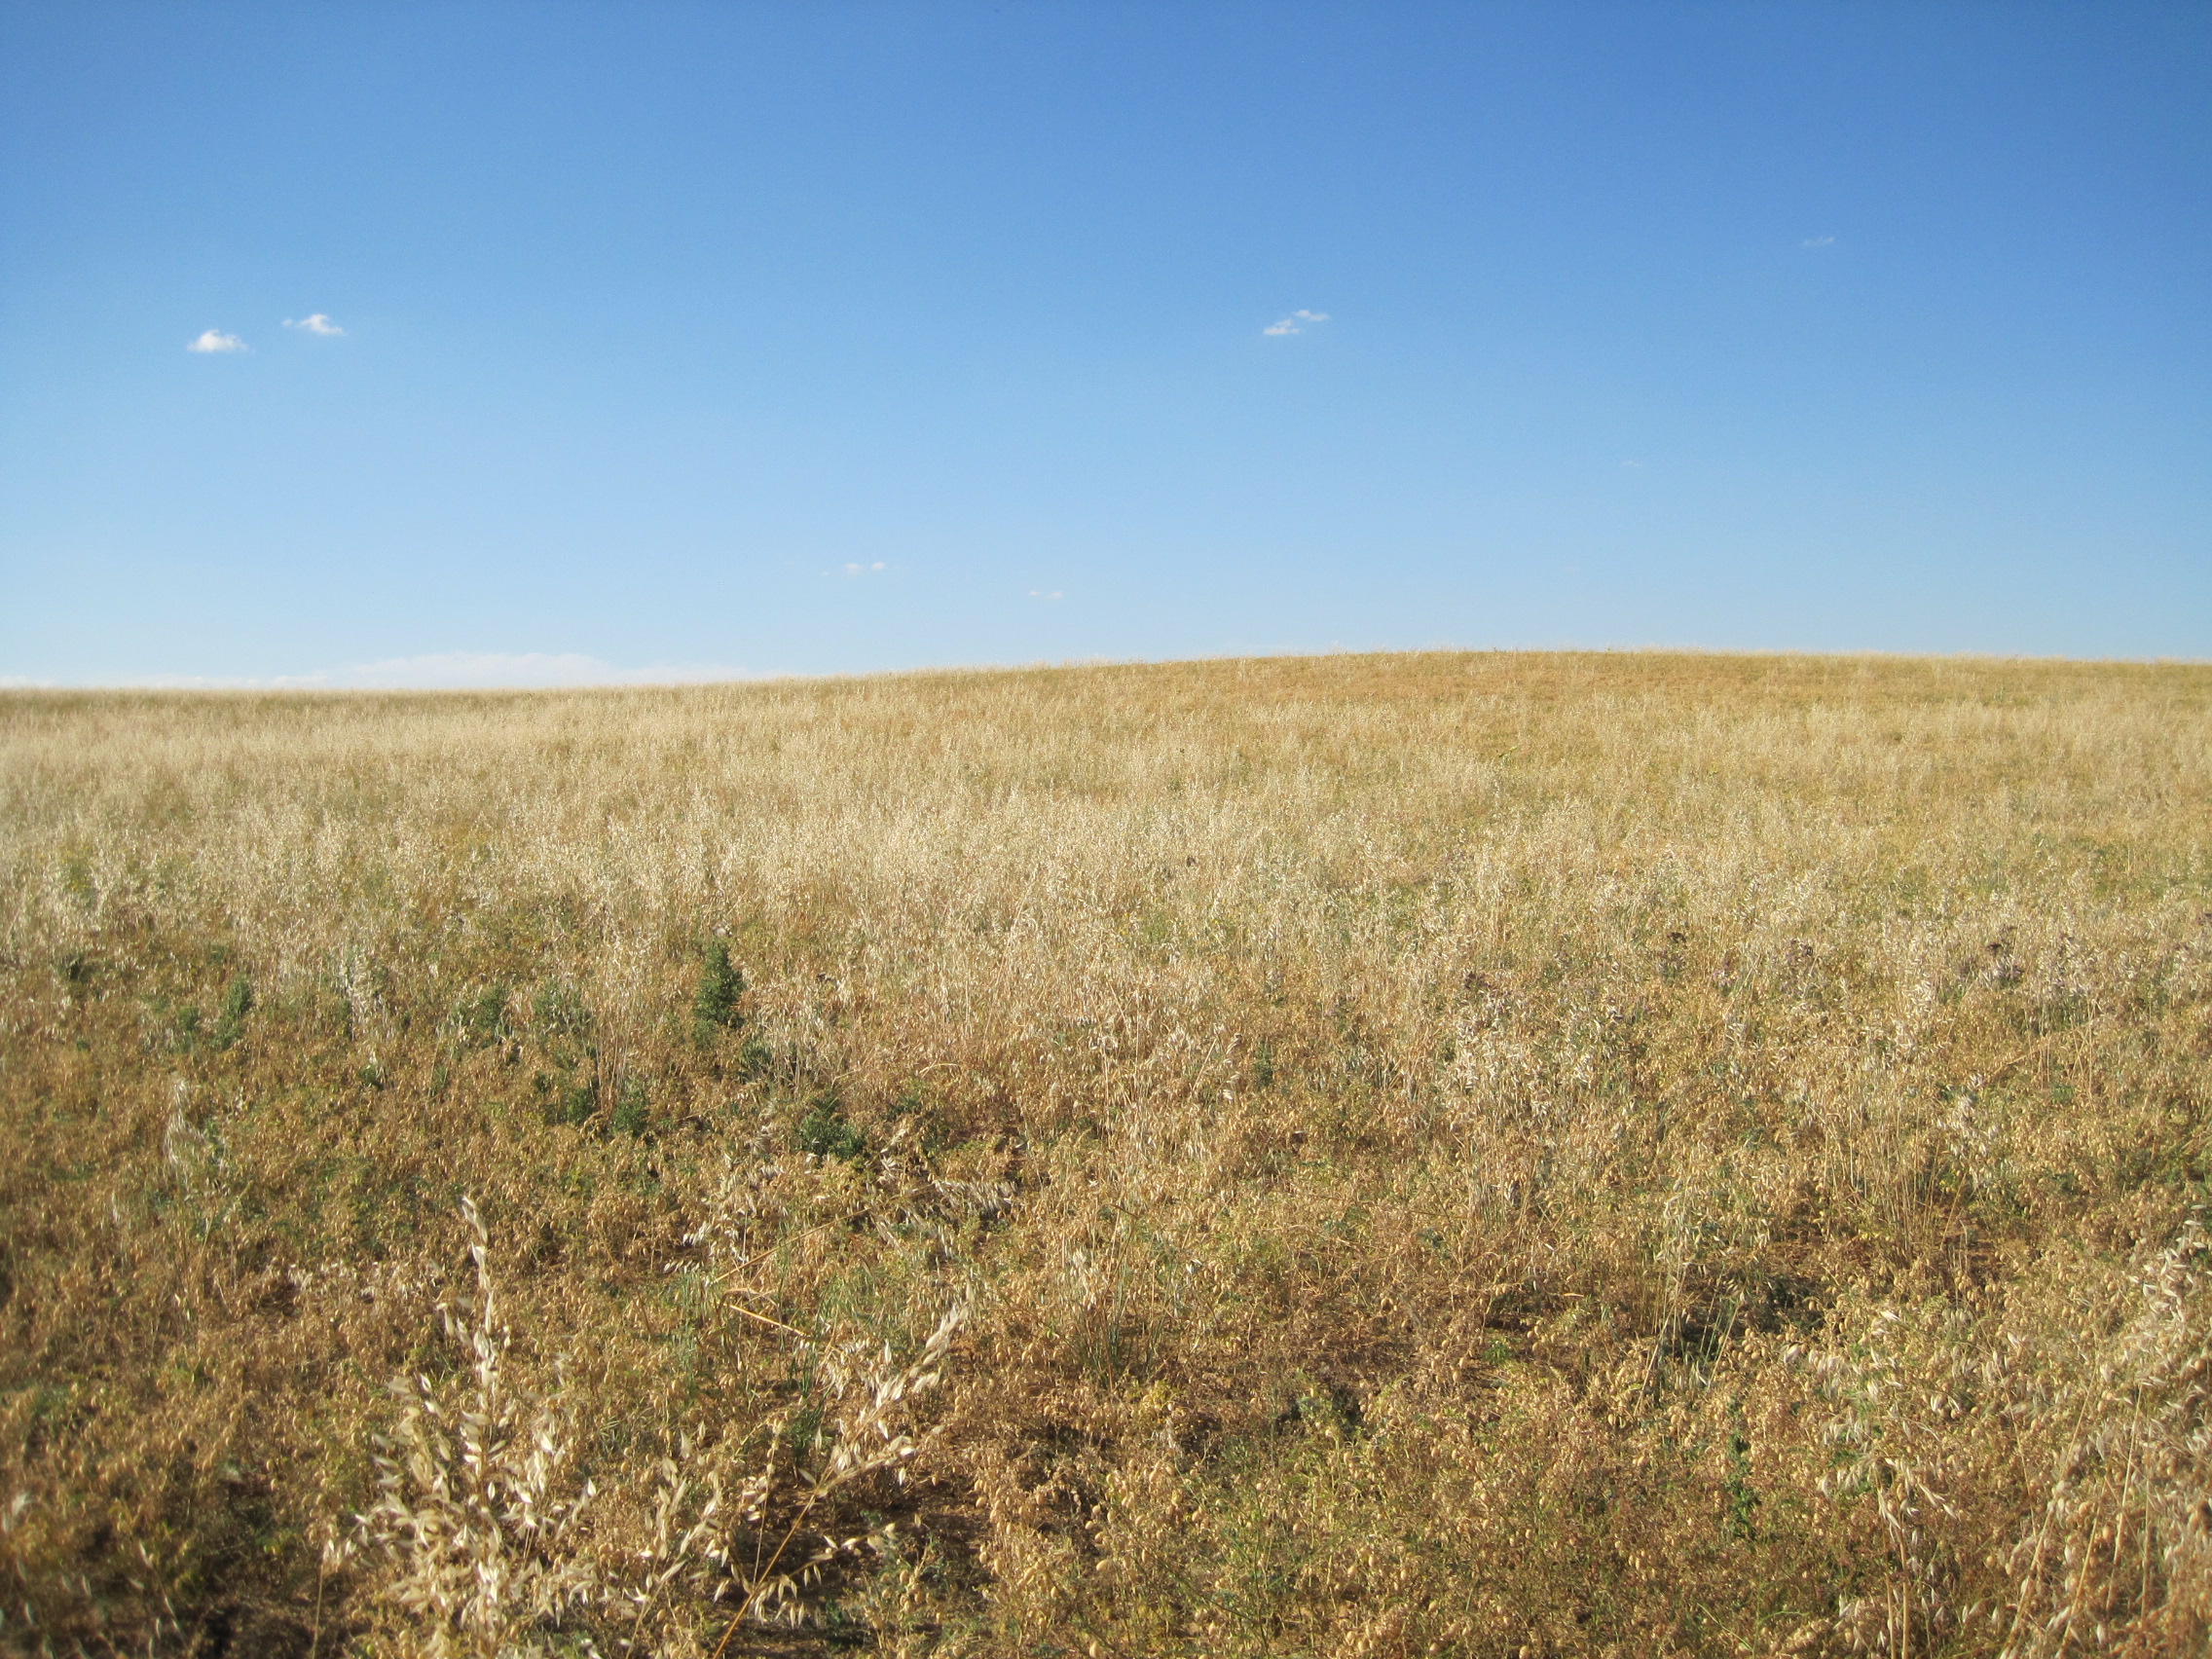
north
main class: Cropland
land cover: Dry pulses
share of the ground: > 75 %
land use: Agriculture (excluding fallow land and kitchen gardens)
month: July
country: ES
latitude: 42.1381
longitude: -5.2202
